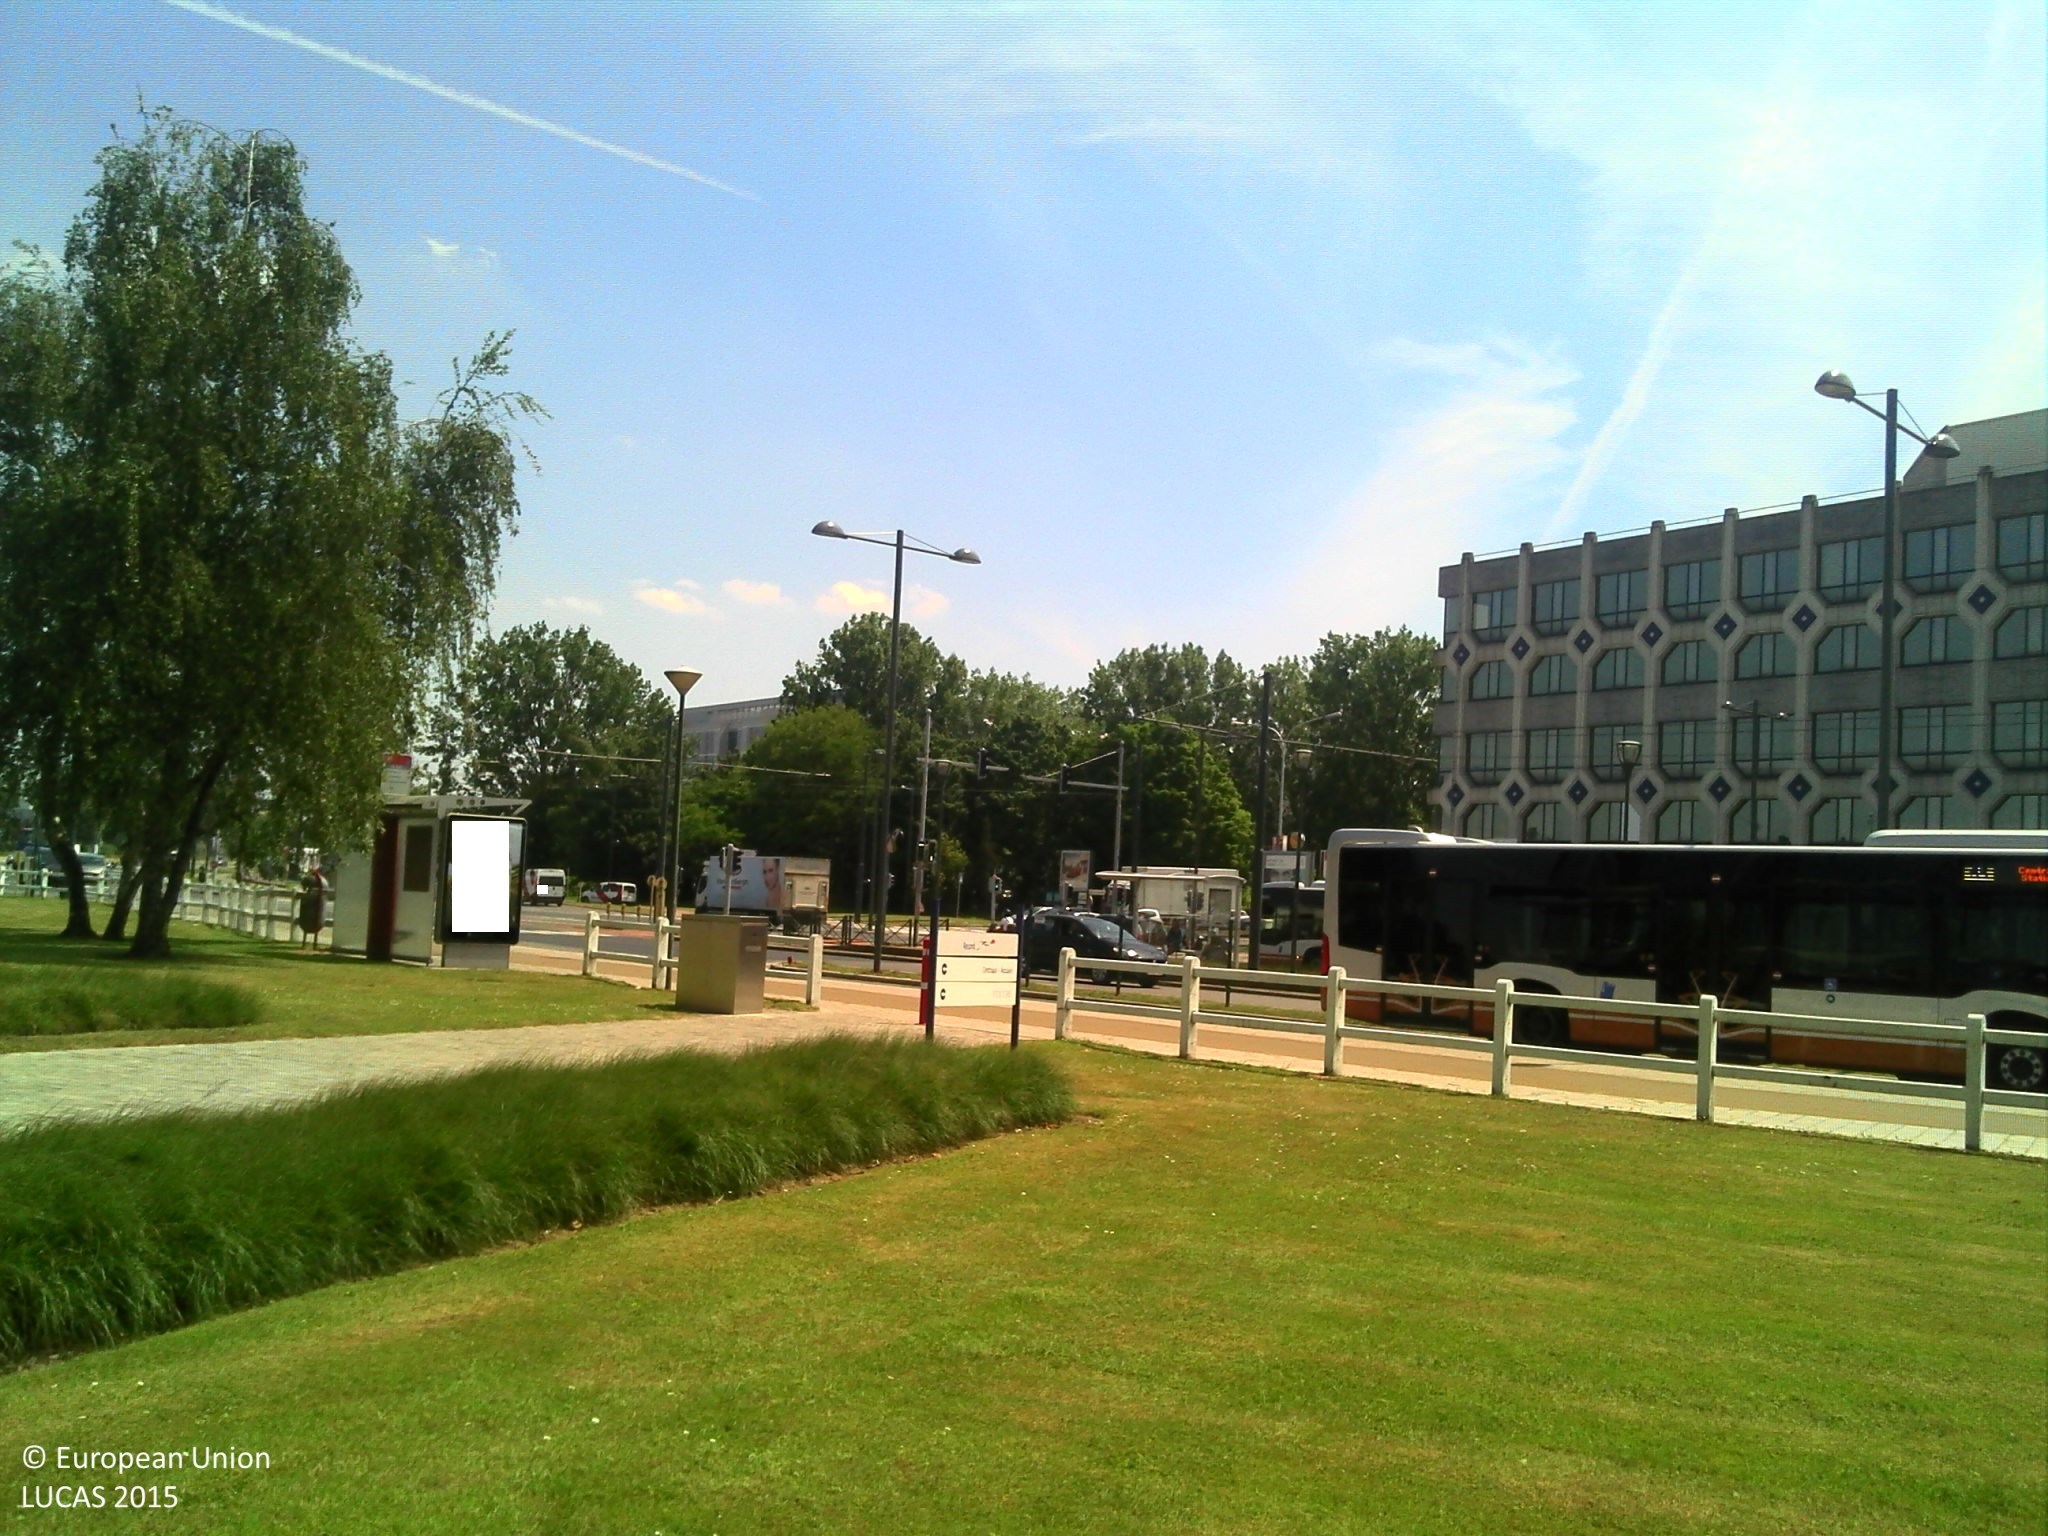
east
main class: Grassland
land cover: Grassland with sparse tree/shrub cover
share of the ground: > 75 %
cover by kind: herbaceous plants 90 %, broadleaved forest trees 5 %, shrubs 5 %
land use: Commerce
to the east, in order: Grassland with sparse tree/shrub cover; Artificial constructions in urban areas; Broadleaved woodland; Artificial constructions in urban areas
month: June
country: BE
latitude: 50.8763
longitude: 4.4102
